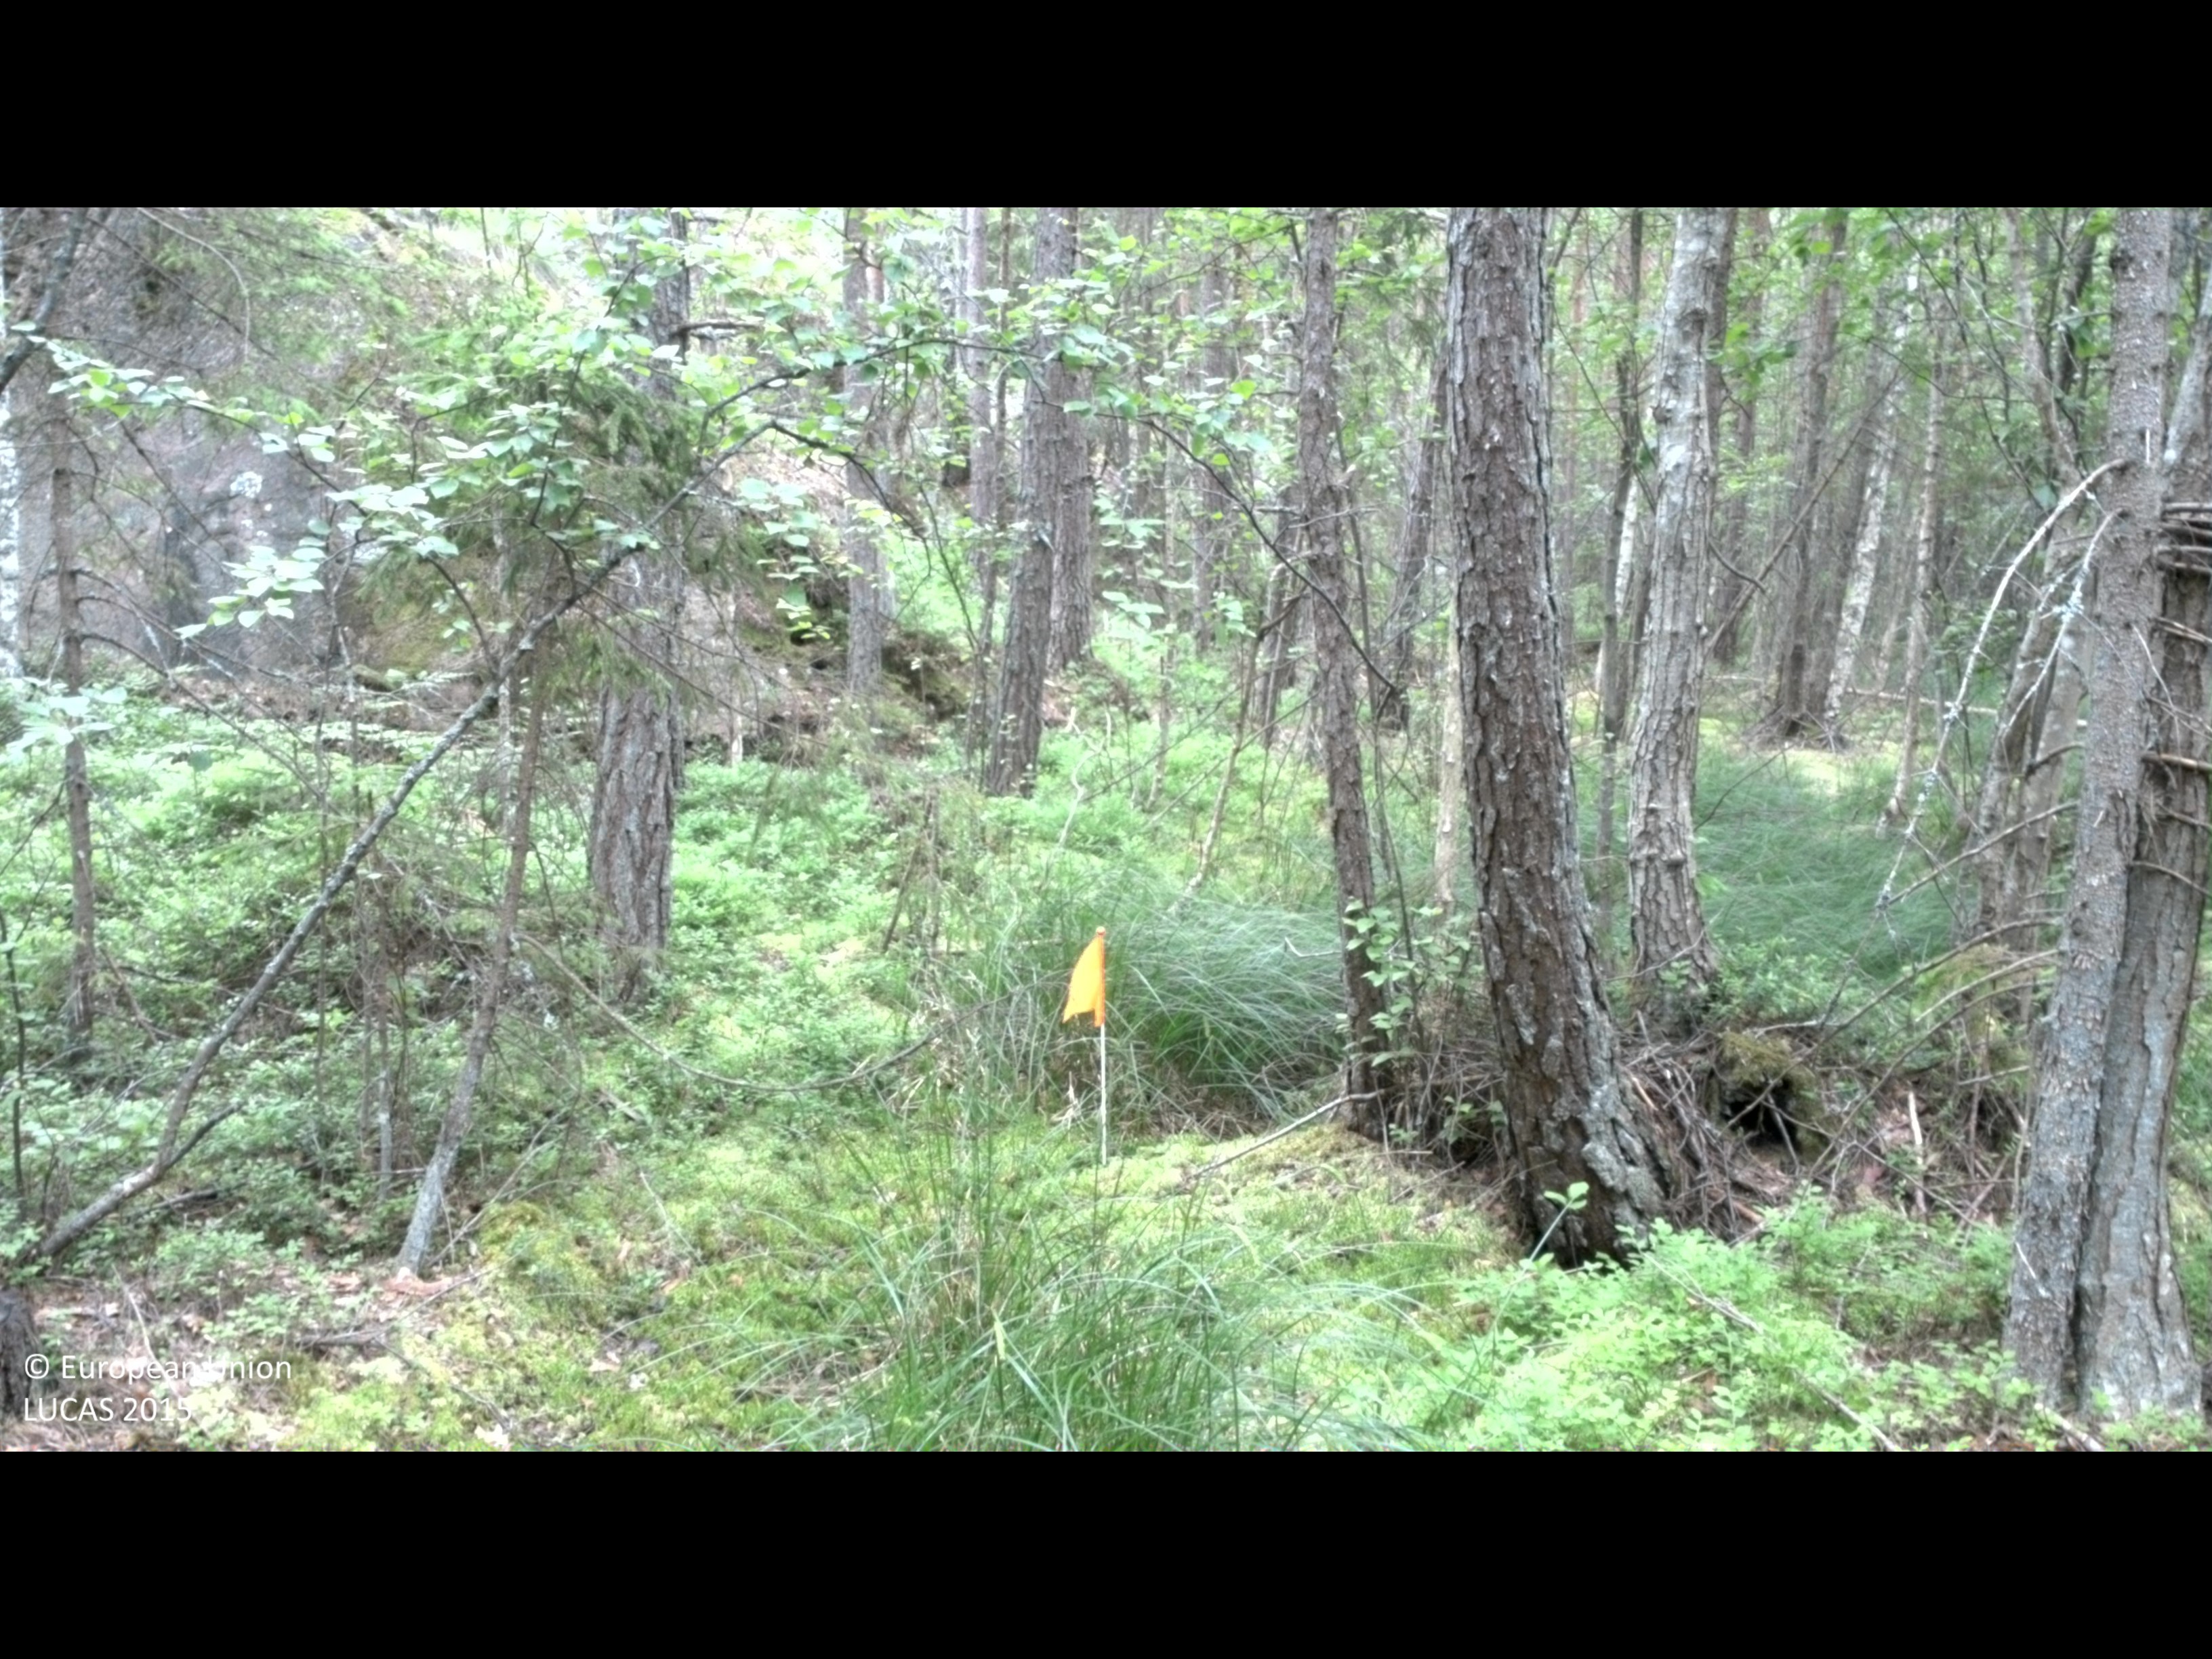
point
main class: Woodland
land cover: Pine dominated mixed woodland
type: boreal forest
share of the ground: > 75 %
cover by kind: coniferous forest trees 50 %, broadleaved forest trees 25 %, shrubs 15 %, herbaceous plants 5 %, lichens and mosses 5 %
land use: Forestry
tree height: > 5 m
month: June
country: SE
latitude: 57.9684
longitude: 16.5738
